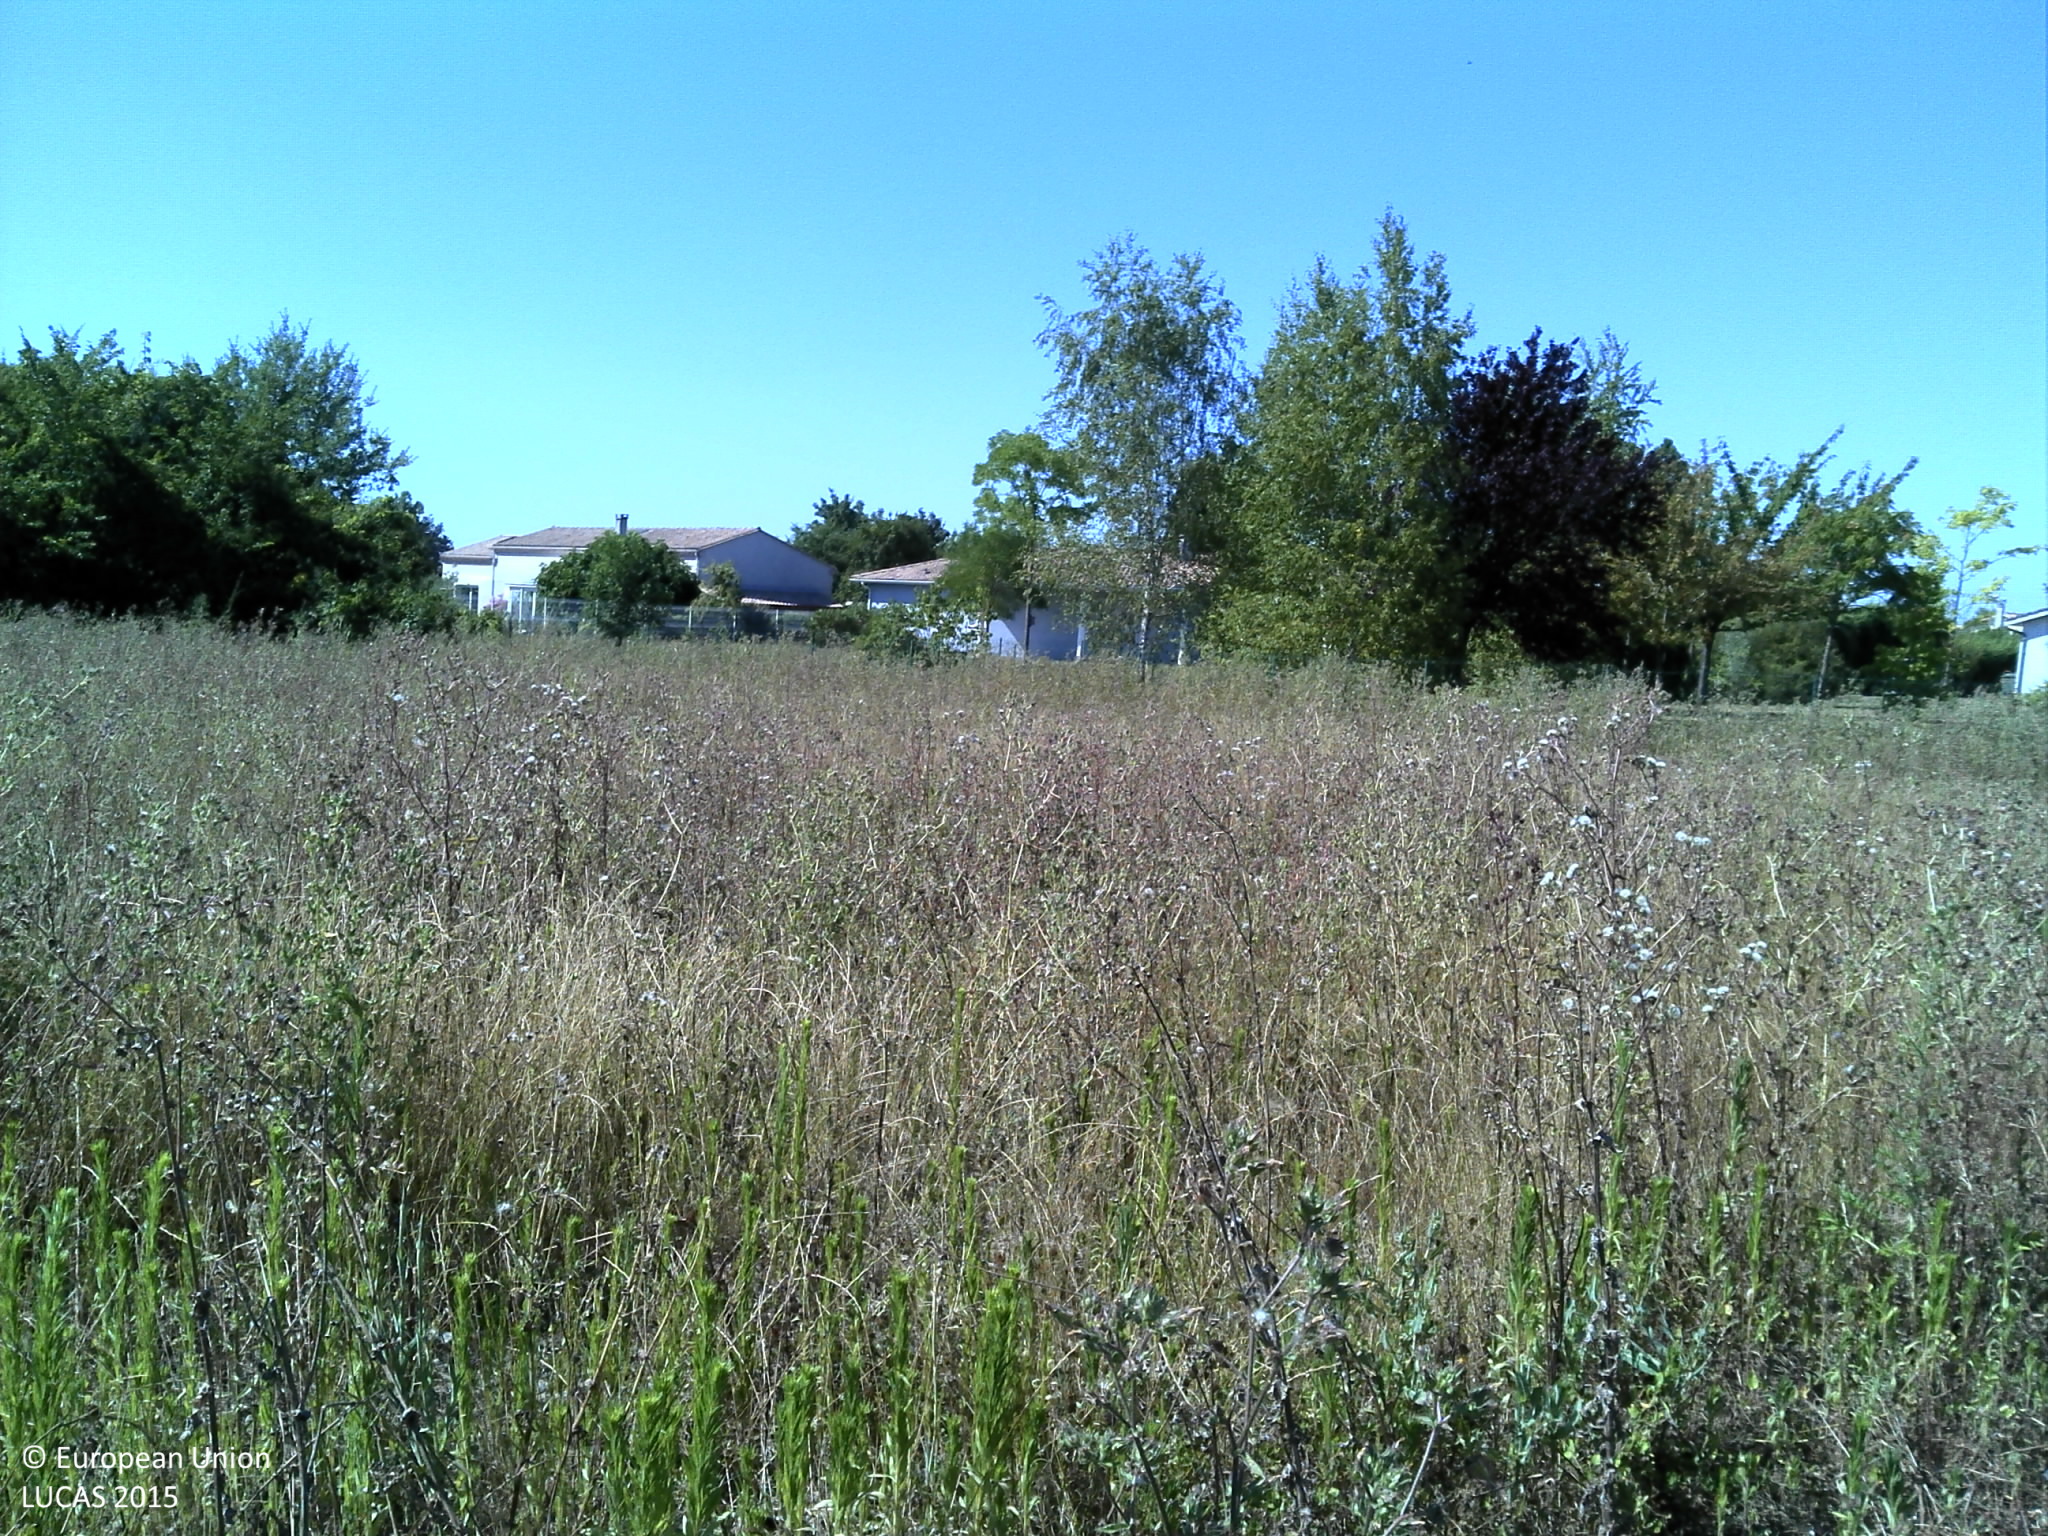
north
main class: Grassland
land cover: Spontaneously vegetated surfaces
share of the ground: > 75 %
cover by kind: herbaceous plants 100 %
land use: Abandoned areas
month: July
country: FR
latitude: 44.9100
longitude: -0.4674
